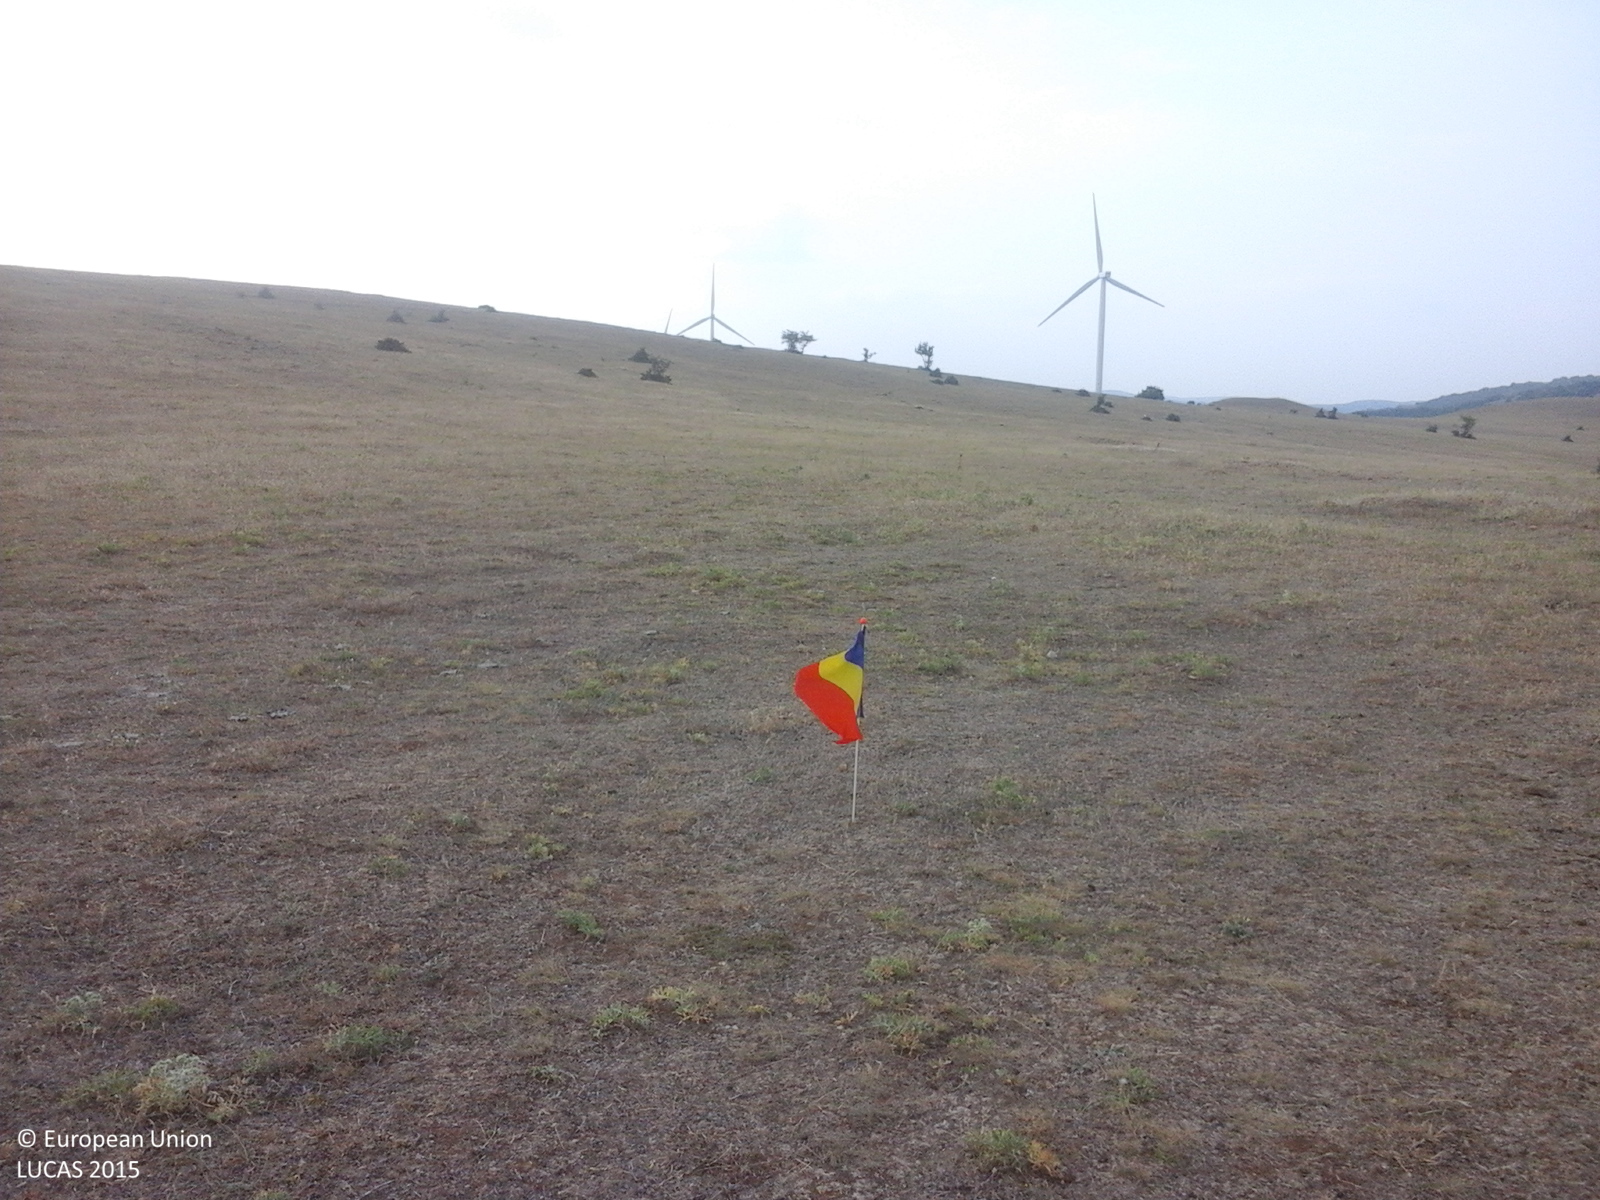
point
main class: Grassland
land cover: Grassland without tree/shrub cover
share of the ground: > 75 %
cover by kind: herbaceous plants 100 %
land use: Agriculture (excluding fallow land and kitchen gardens)
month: July
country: RO
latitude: 45.0600
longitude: 28.3478
